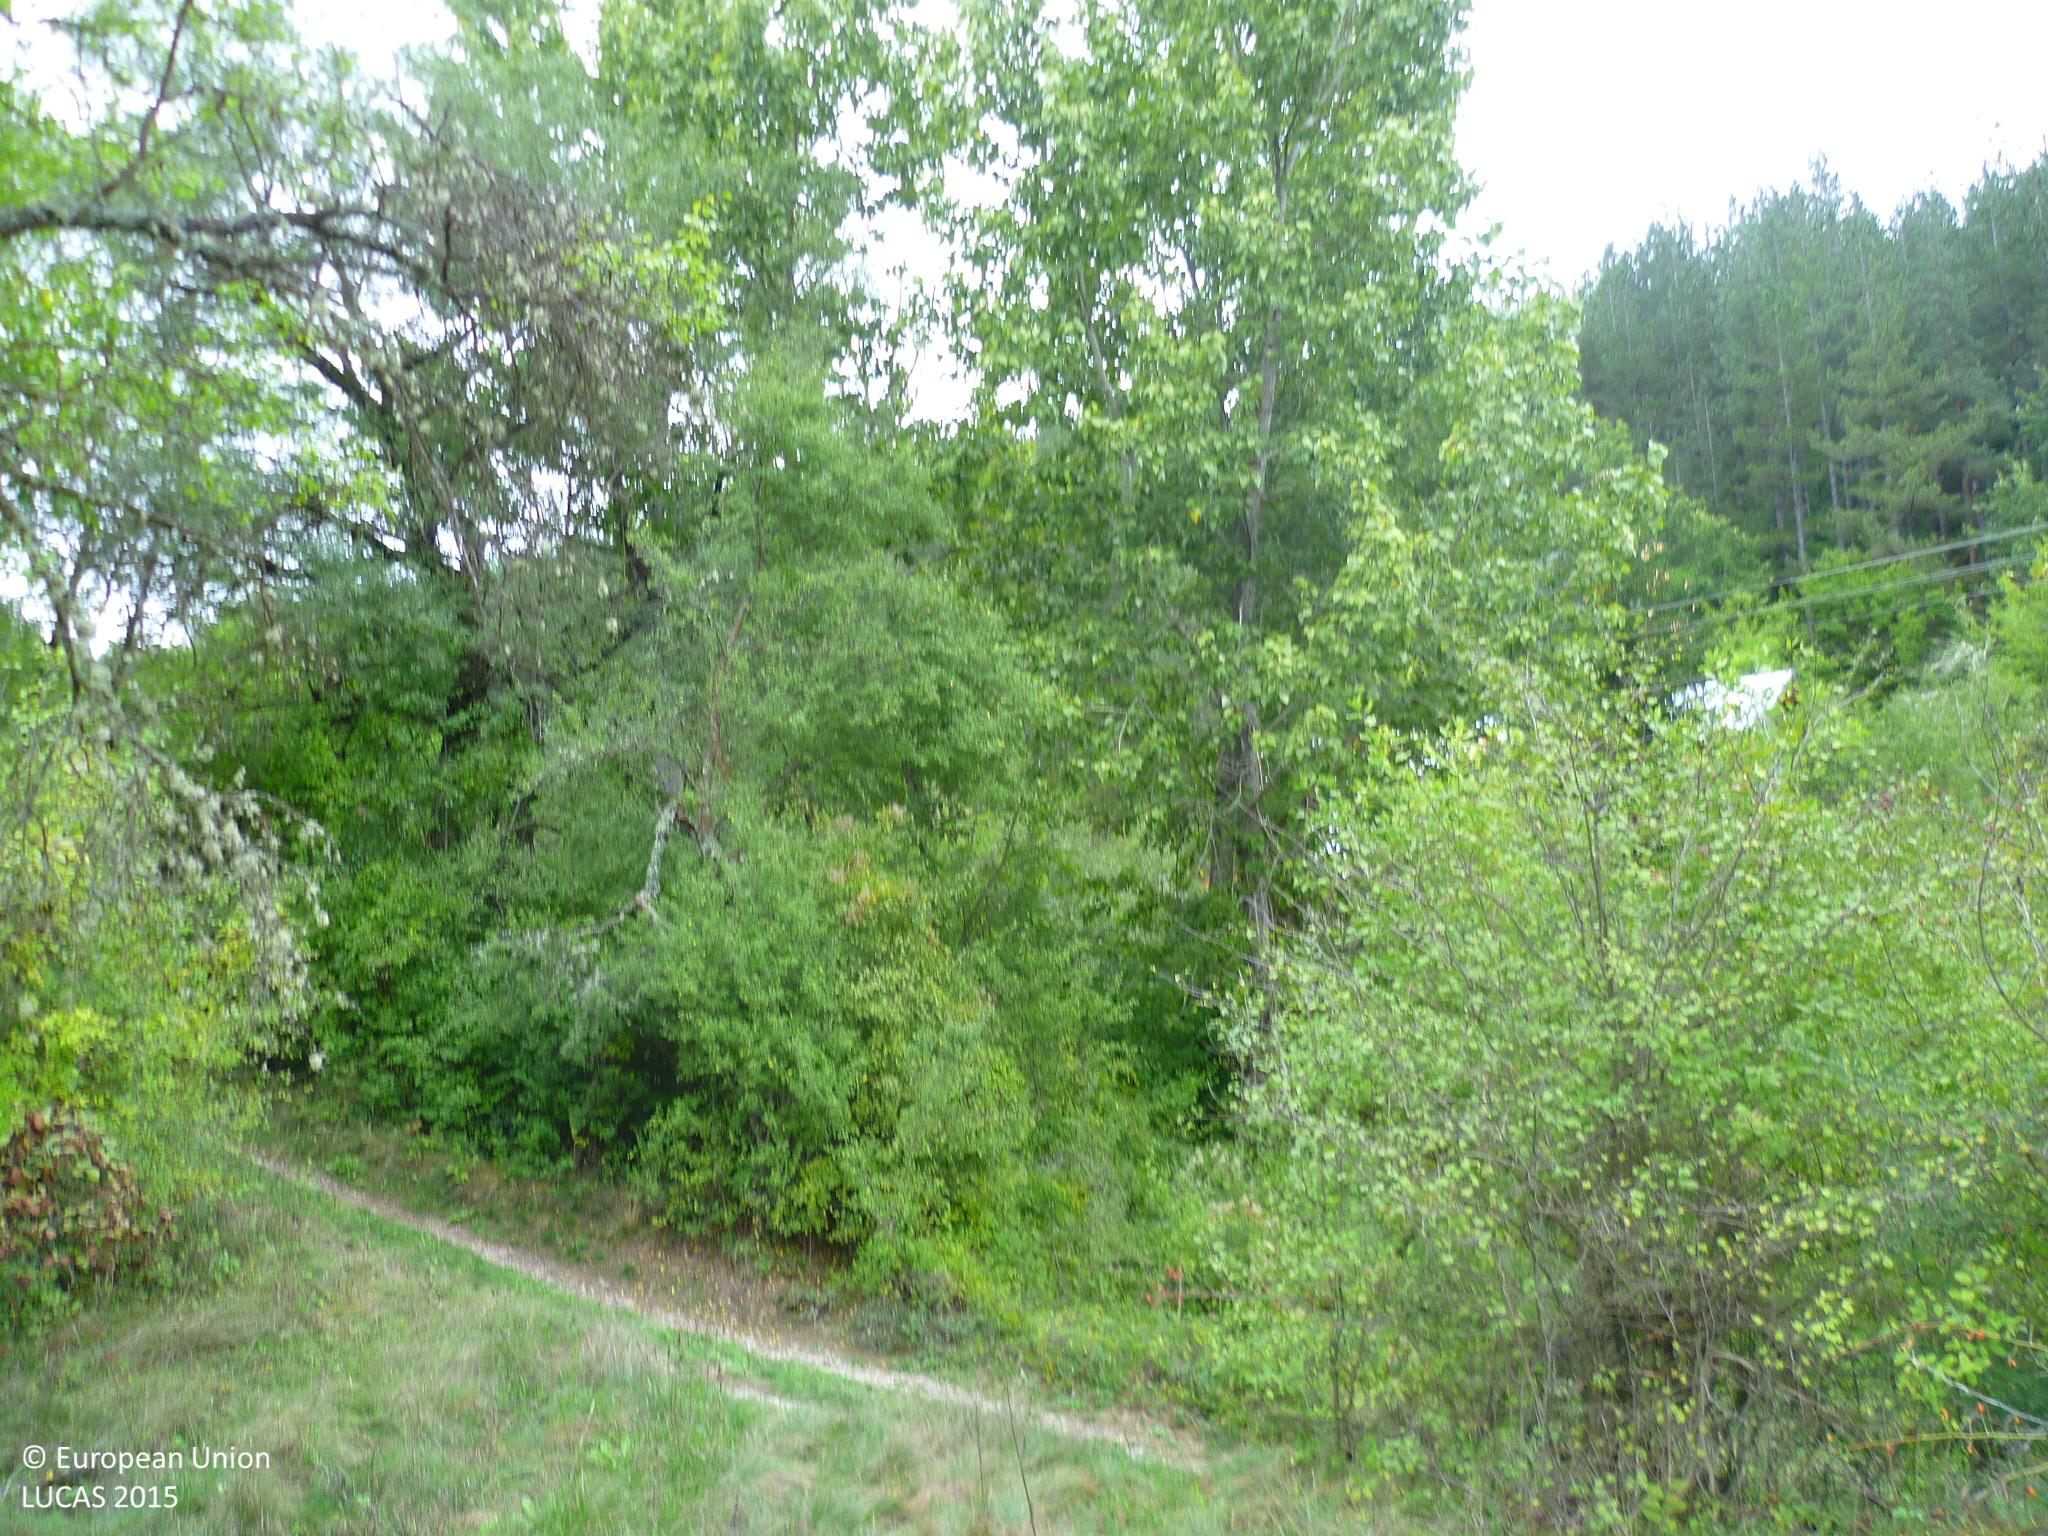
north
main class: Grassland
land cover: Grassland with sparse tree/shrub cover
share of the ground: > 75 %
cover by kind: herbaceous plants 90 %, broadleaved forest trees 5 %, shrubs 5 %
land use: Agriculture (excluding fallow land and kitchen gardens)
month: September
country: BG
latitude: 42.5833
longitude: 22.6844
